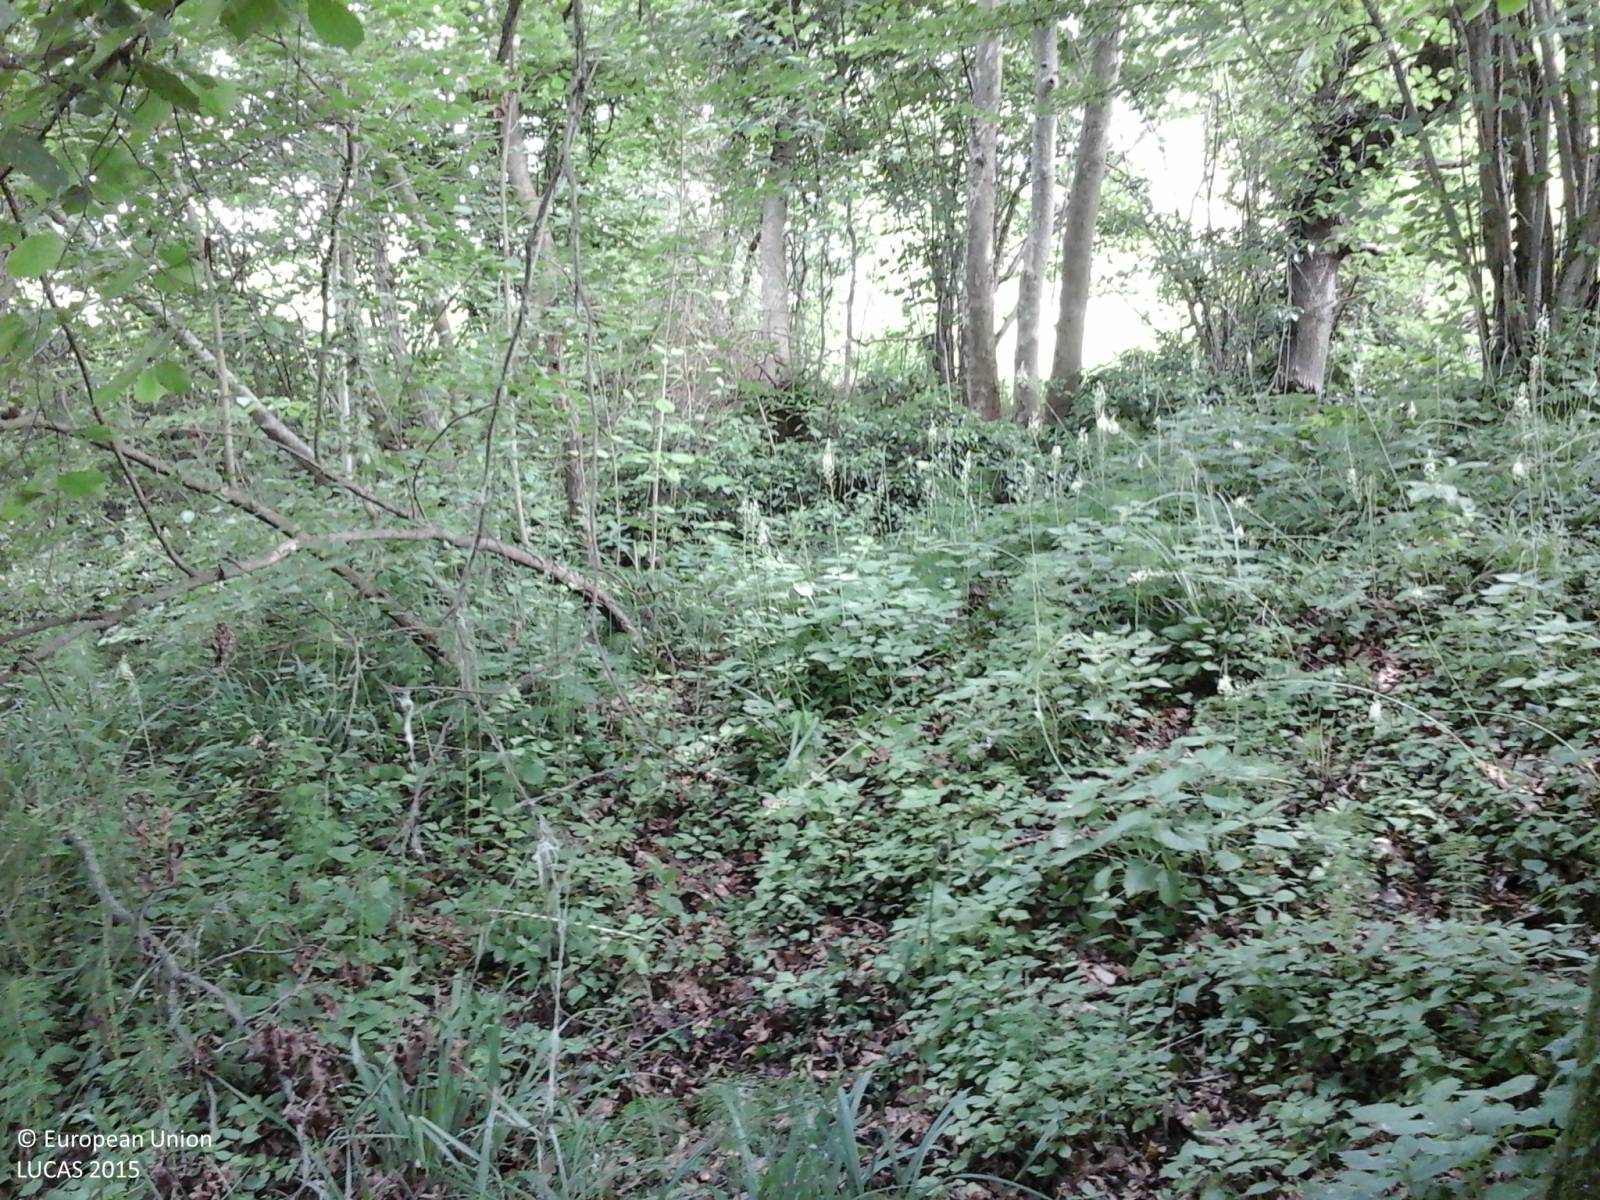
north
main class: Woodland
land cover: Broadleaved woodland
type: thermophilous deciduous forest
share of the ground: > 75 %
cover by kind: broadleaved forest trees 80 %, shrubs 20 %
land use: Forestry
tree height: > 5 m
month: May
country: IT
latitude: 45.8698
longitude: 13.2296
